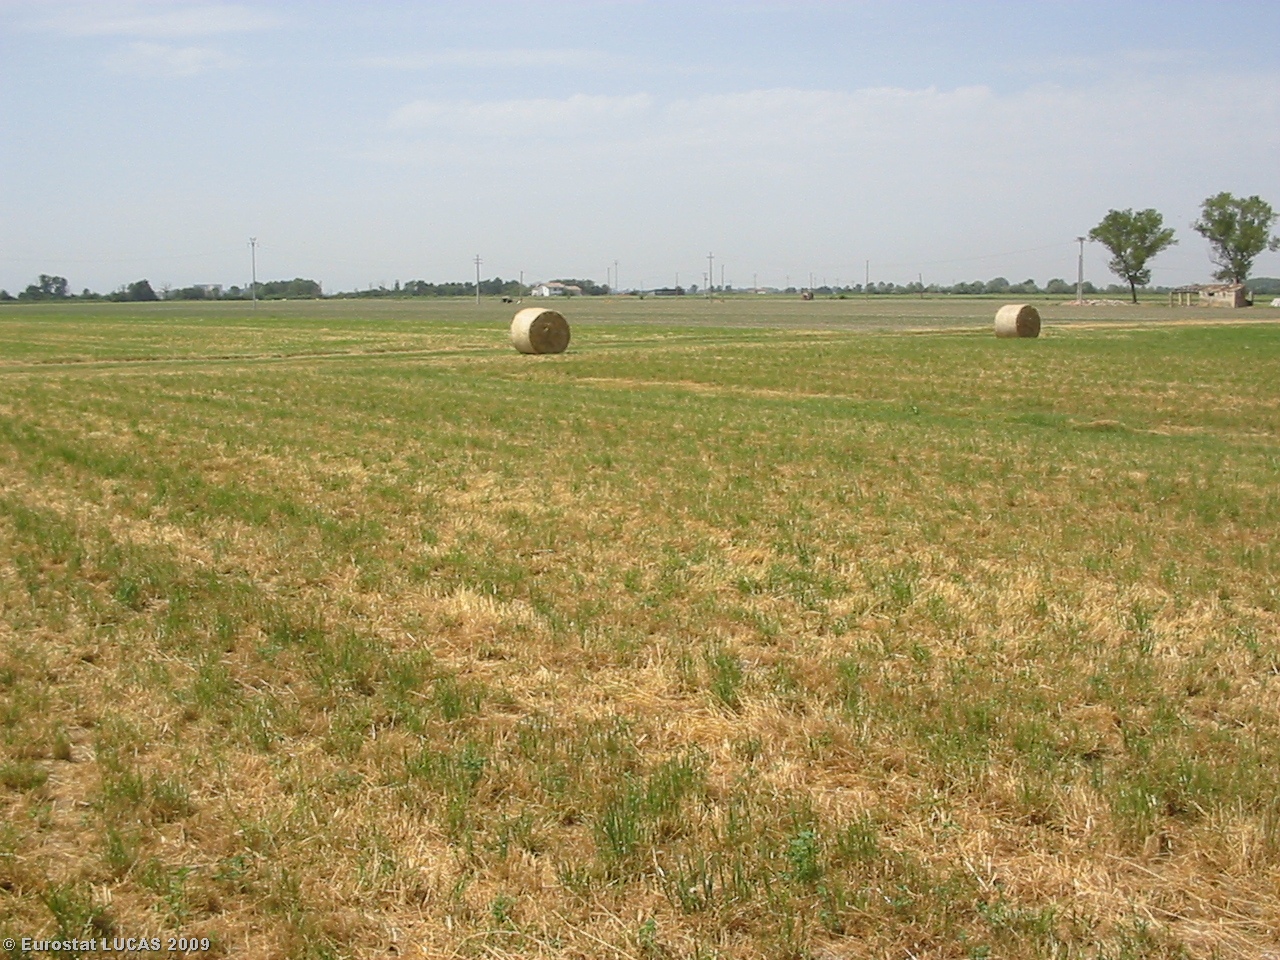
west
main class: Cropland
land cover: Lucerne
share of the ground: < 10 %
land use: Agriculture (excluding fallow land and kitchen gardens)
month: May
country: IT
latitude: 44.9451
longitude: 10.3415
